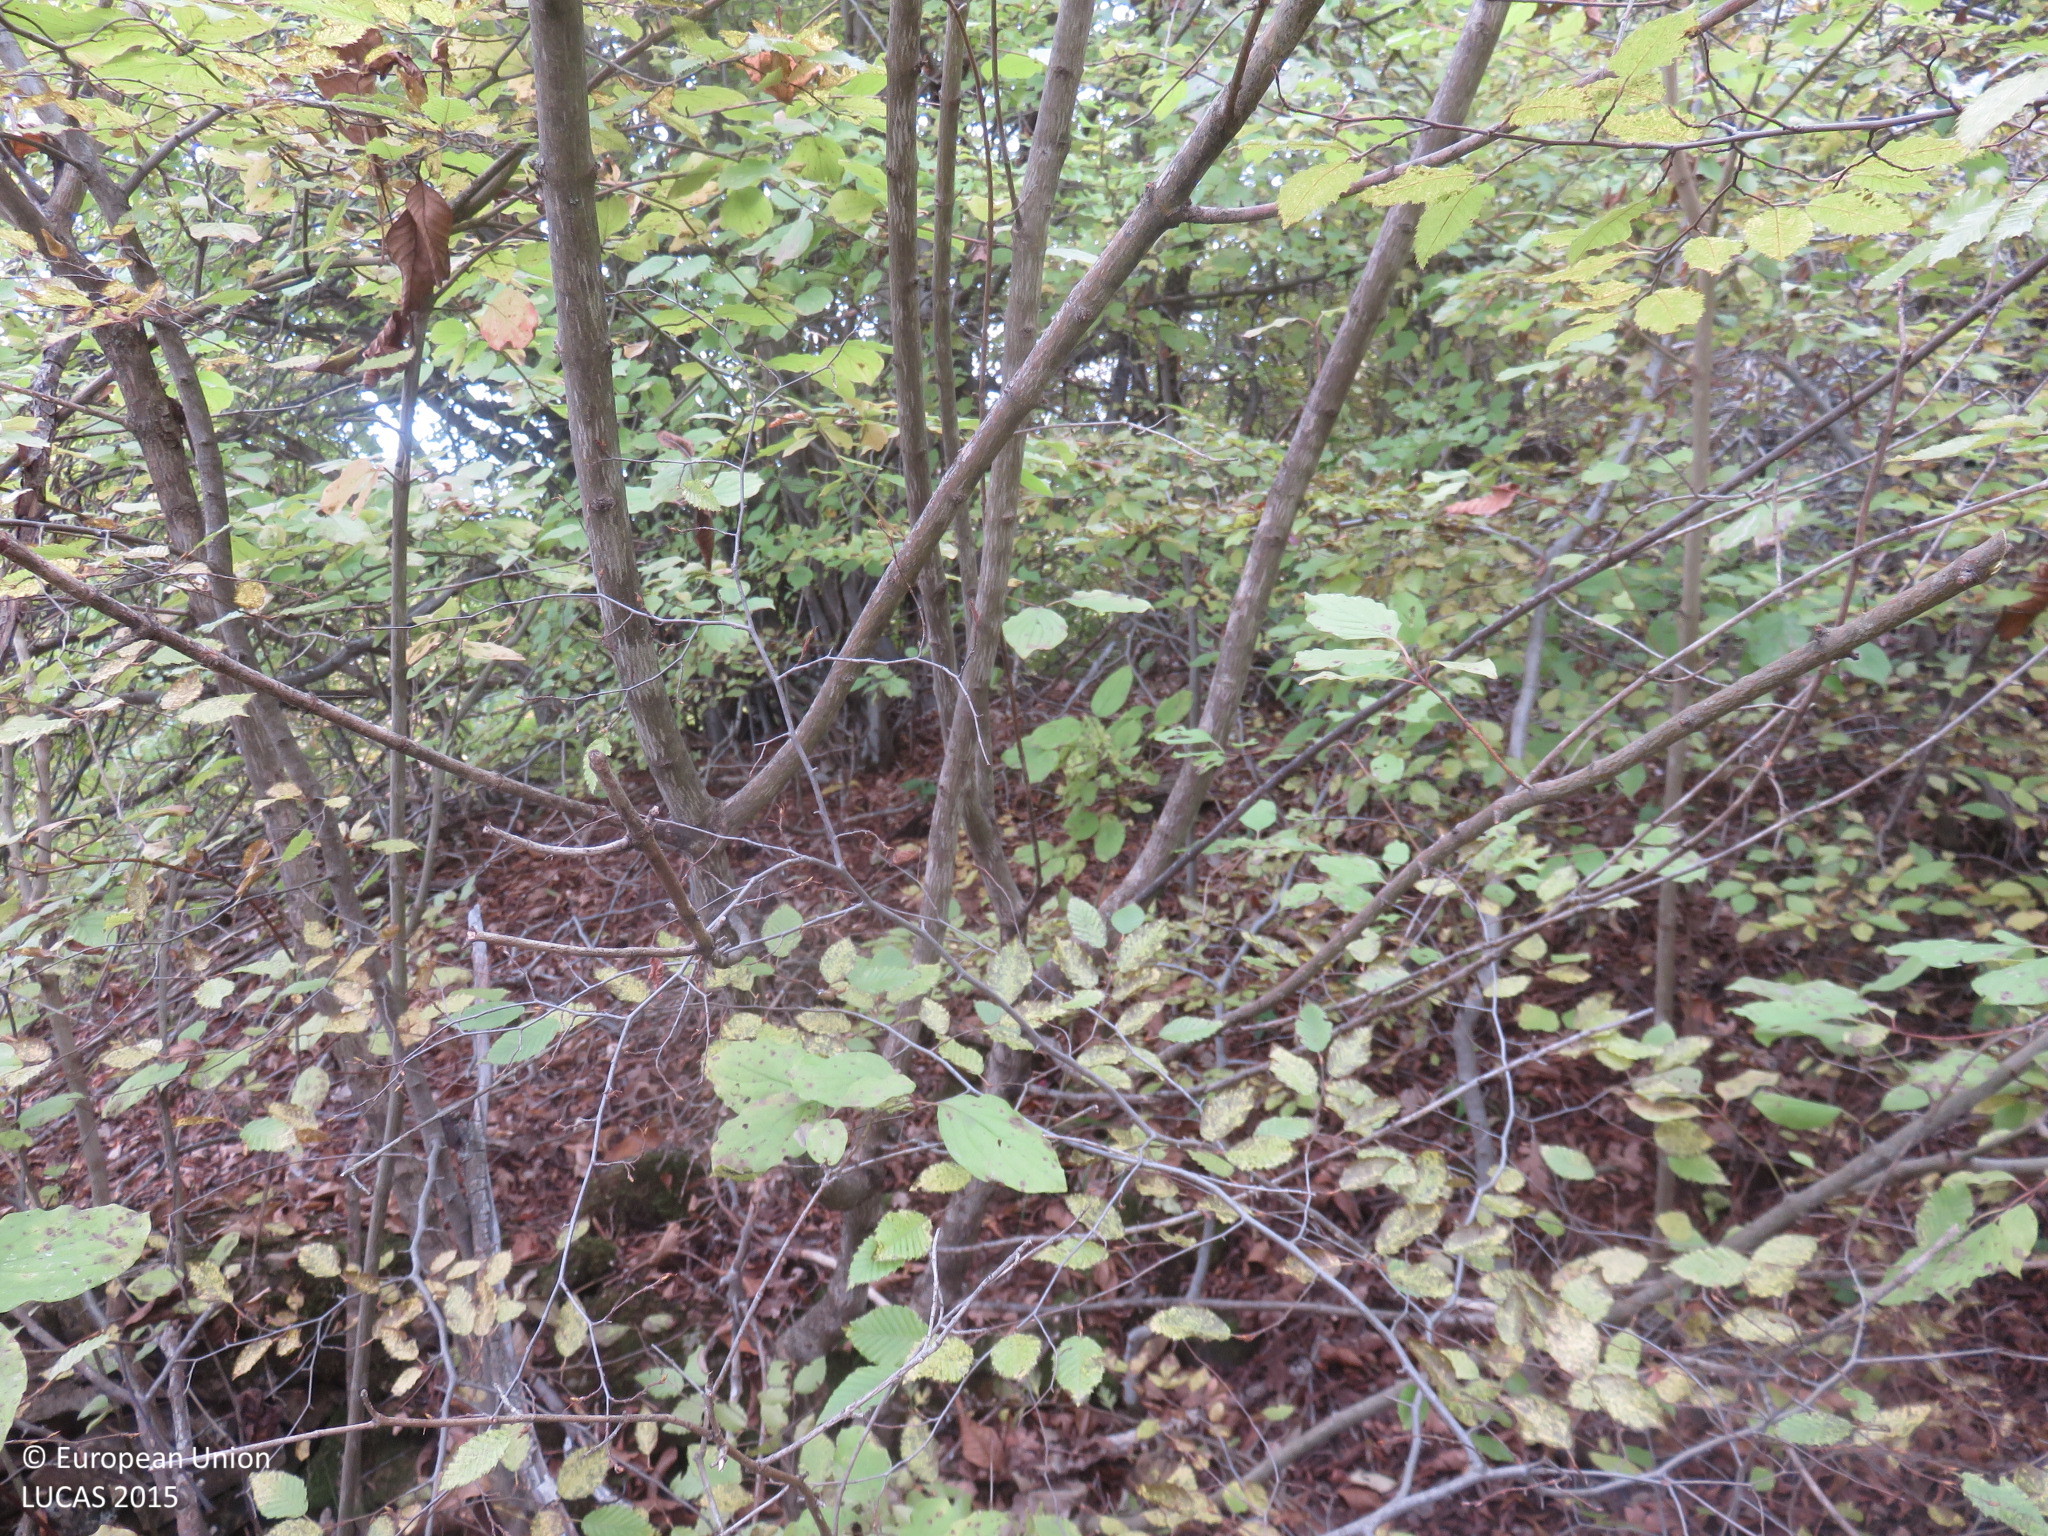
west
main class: Shrubland
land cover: Shrubland with sparse tree cover
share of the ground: > 75 %
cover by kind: shrubs 95 %, broadleaved forest trees 5 %
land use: Semi-natural and natural areas not in use
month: October
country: BG
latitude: 43.0044
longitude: 24.9455
